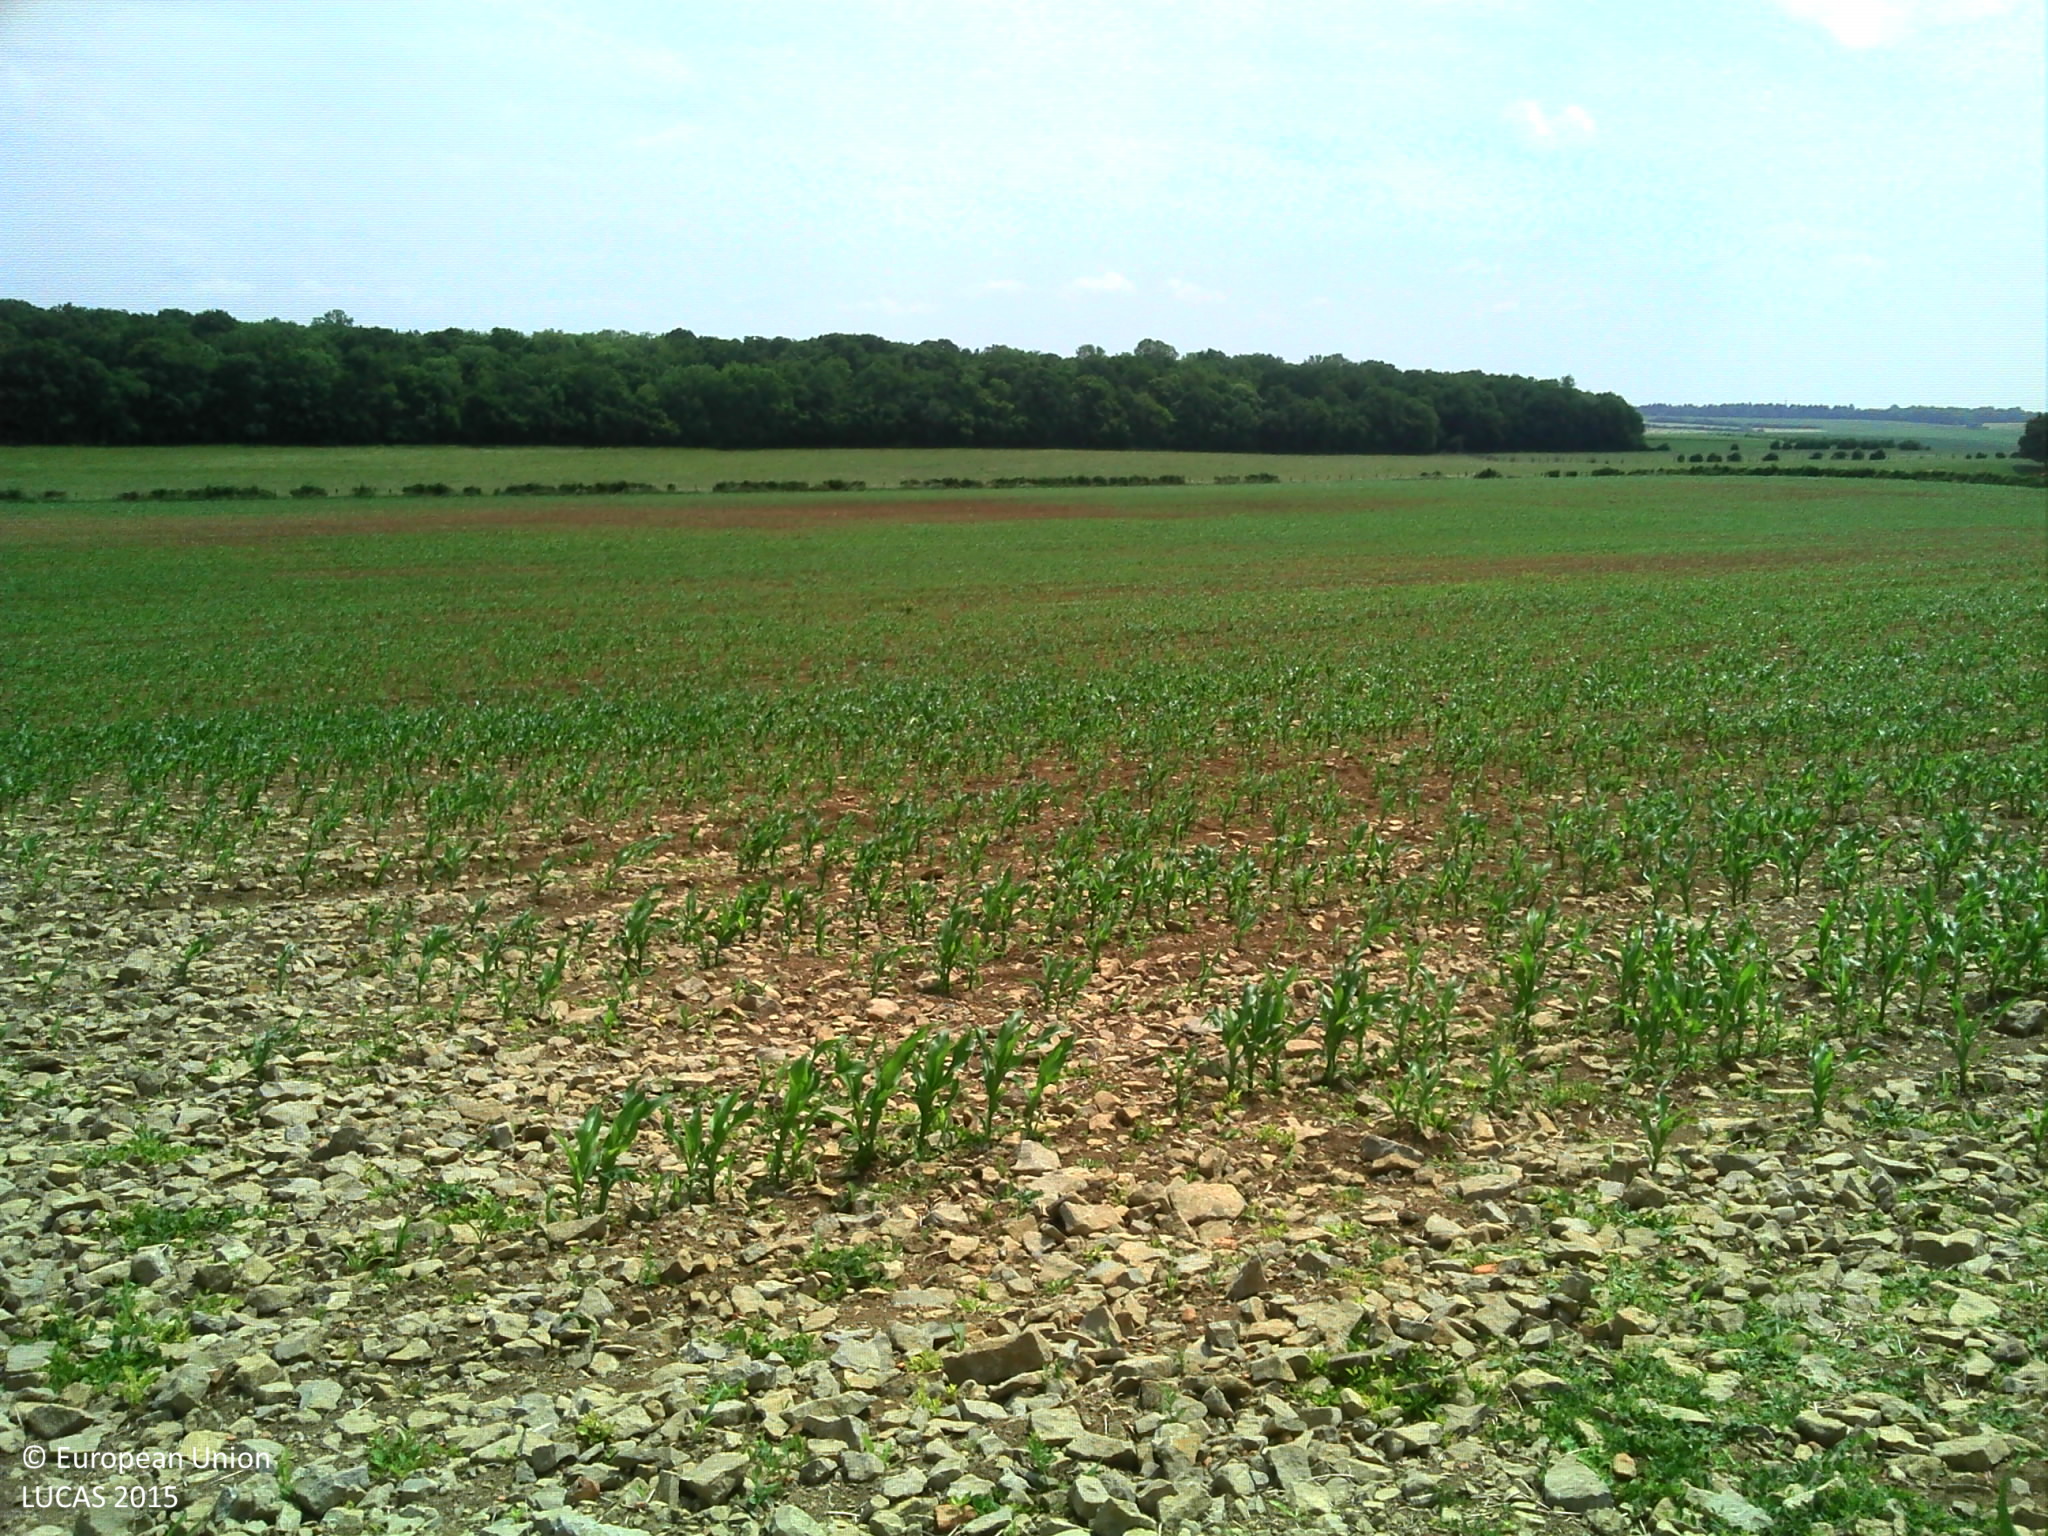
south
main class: Cropland
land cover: Barley
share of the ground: > 75 %
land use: Agriculture (excluding fallow land and kitchen gardens)
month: June
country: FR
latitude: 48.5012
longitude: 6.2242
